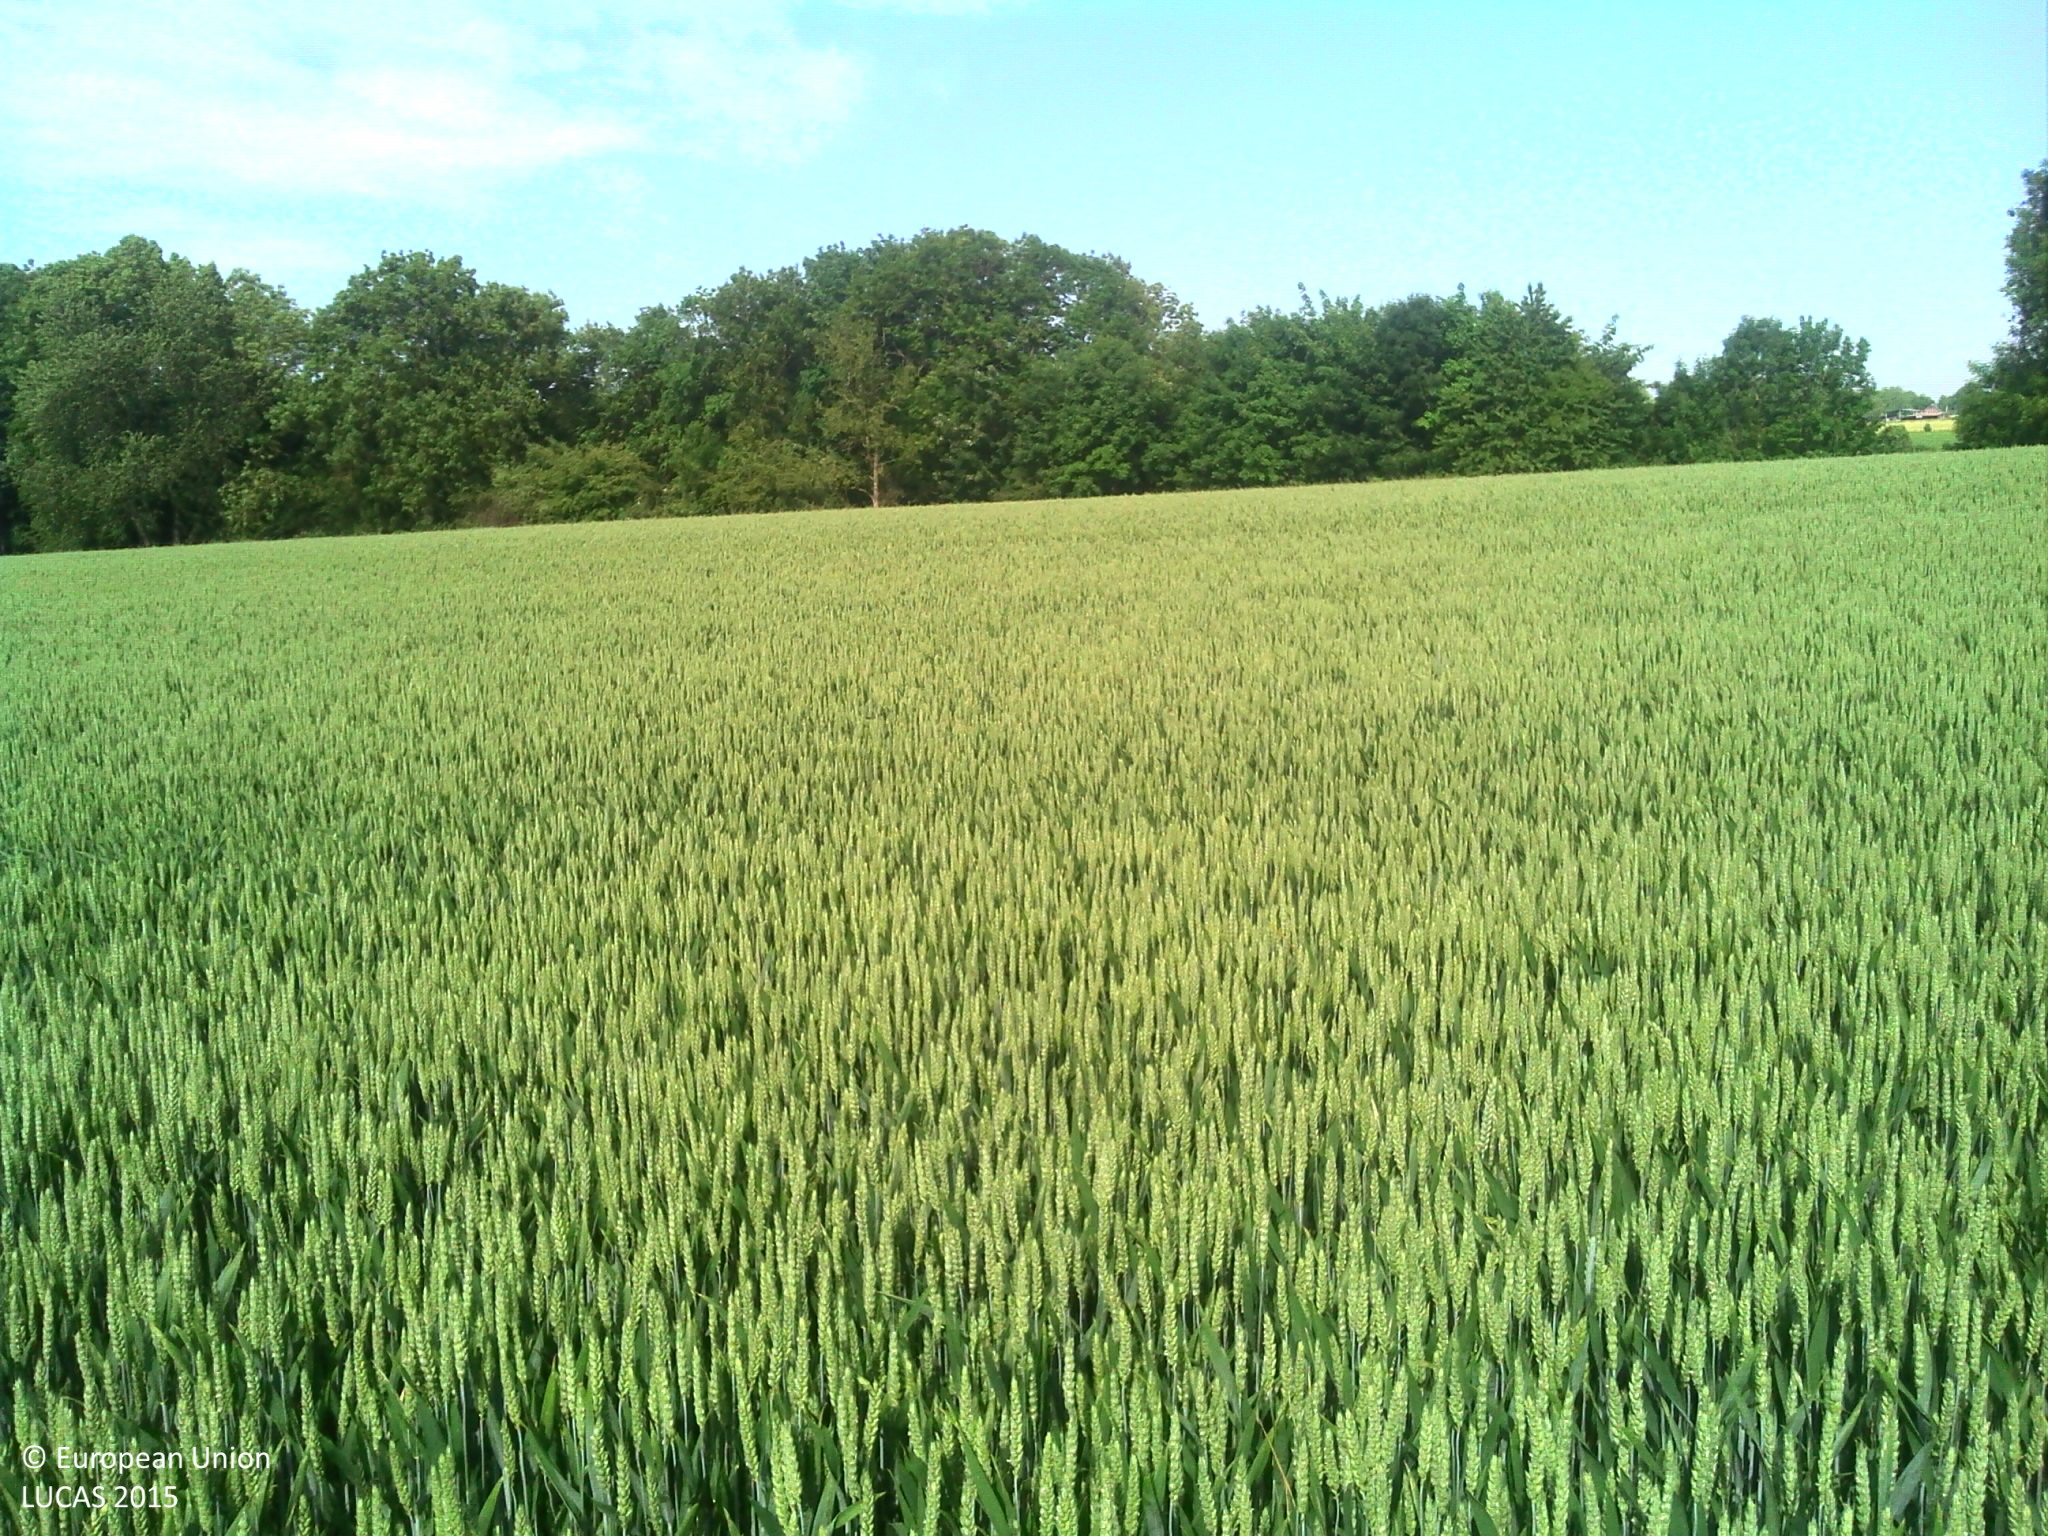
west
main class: Cropland
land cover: Common wheat
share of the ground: > 75 %
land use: Agriculture (excluding fallow land and kitchen gardens)
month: June
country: FR
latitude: 49.8116
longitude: 4.0329
